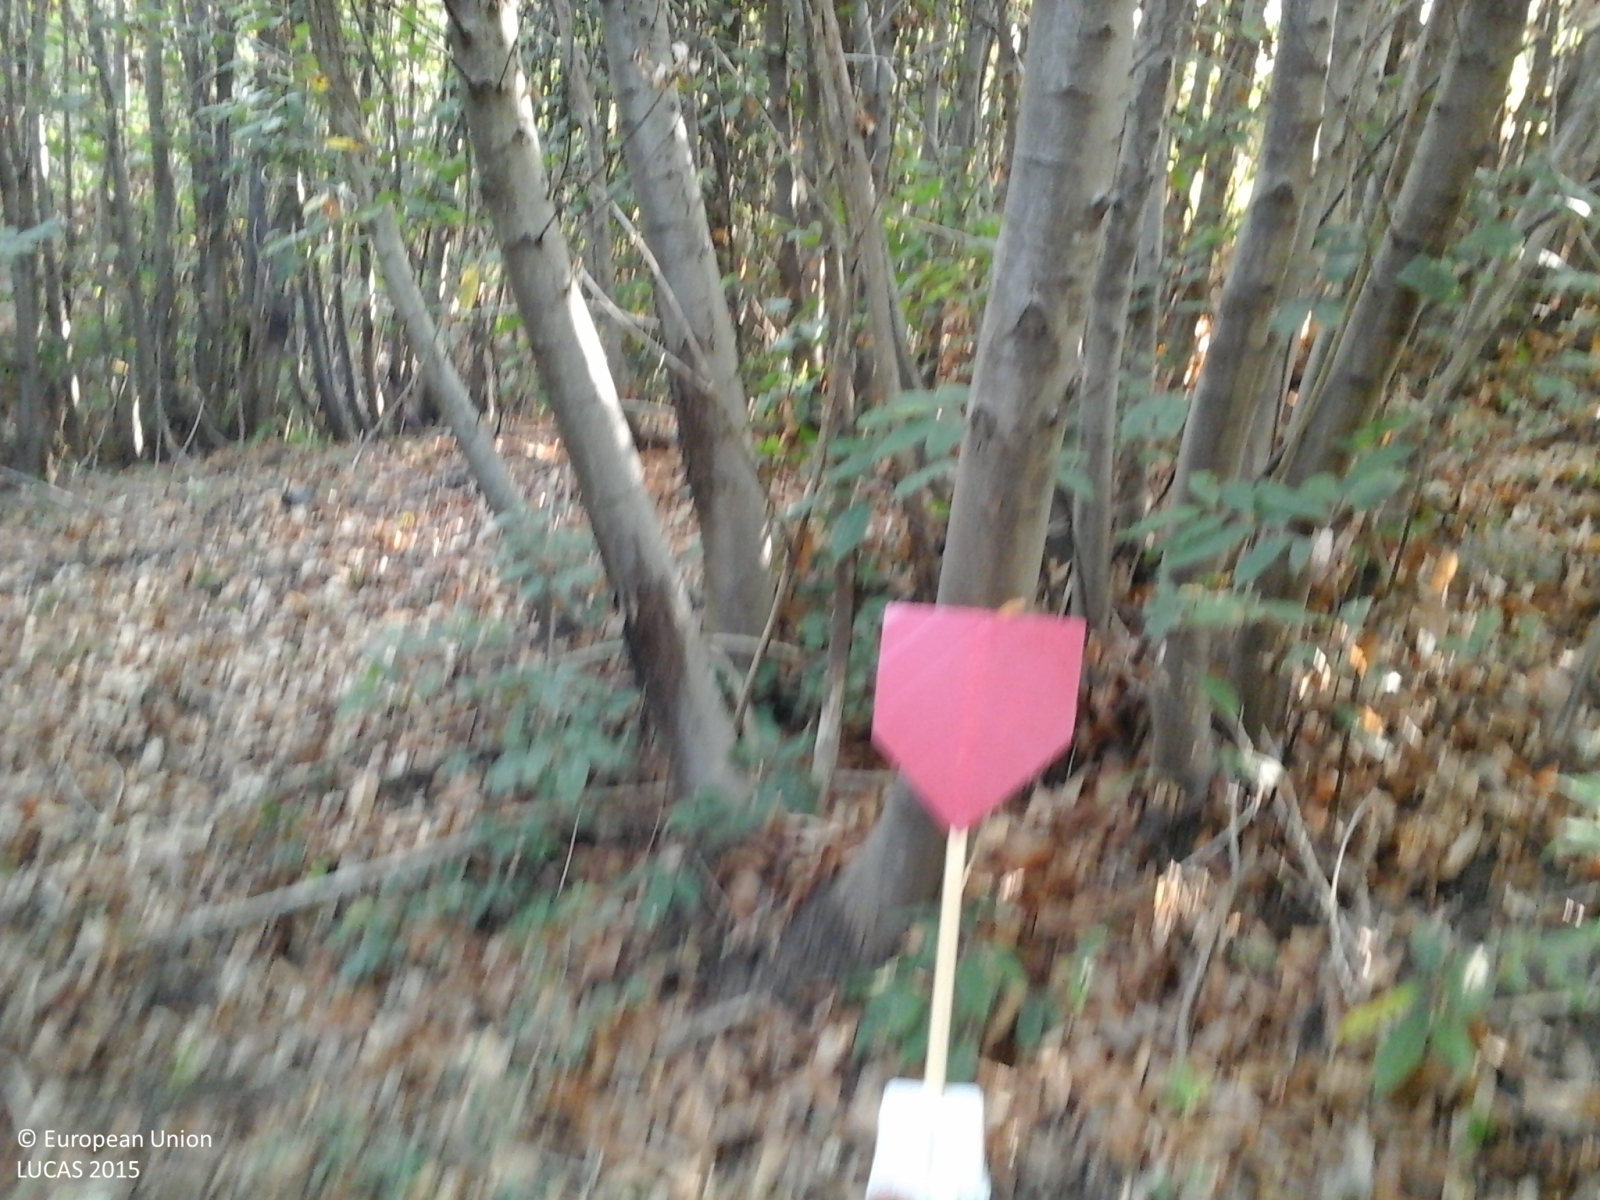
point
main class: Woodland
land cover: Broadleaved woodland
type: thermophilous deciduous forest
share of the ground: > 75 %
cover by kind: broadleaved forest trees 90 %, shrubs 10 %
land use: Semi-natural and natural areas not in use
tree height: > 5 m
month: September
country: IT
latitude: 44.3368
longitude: 8.3106
